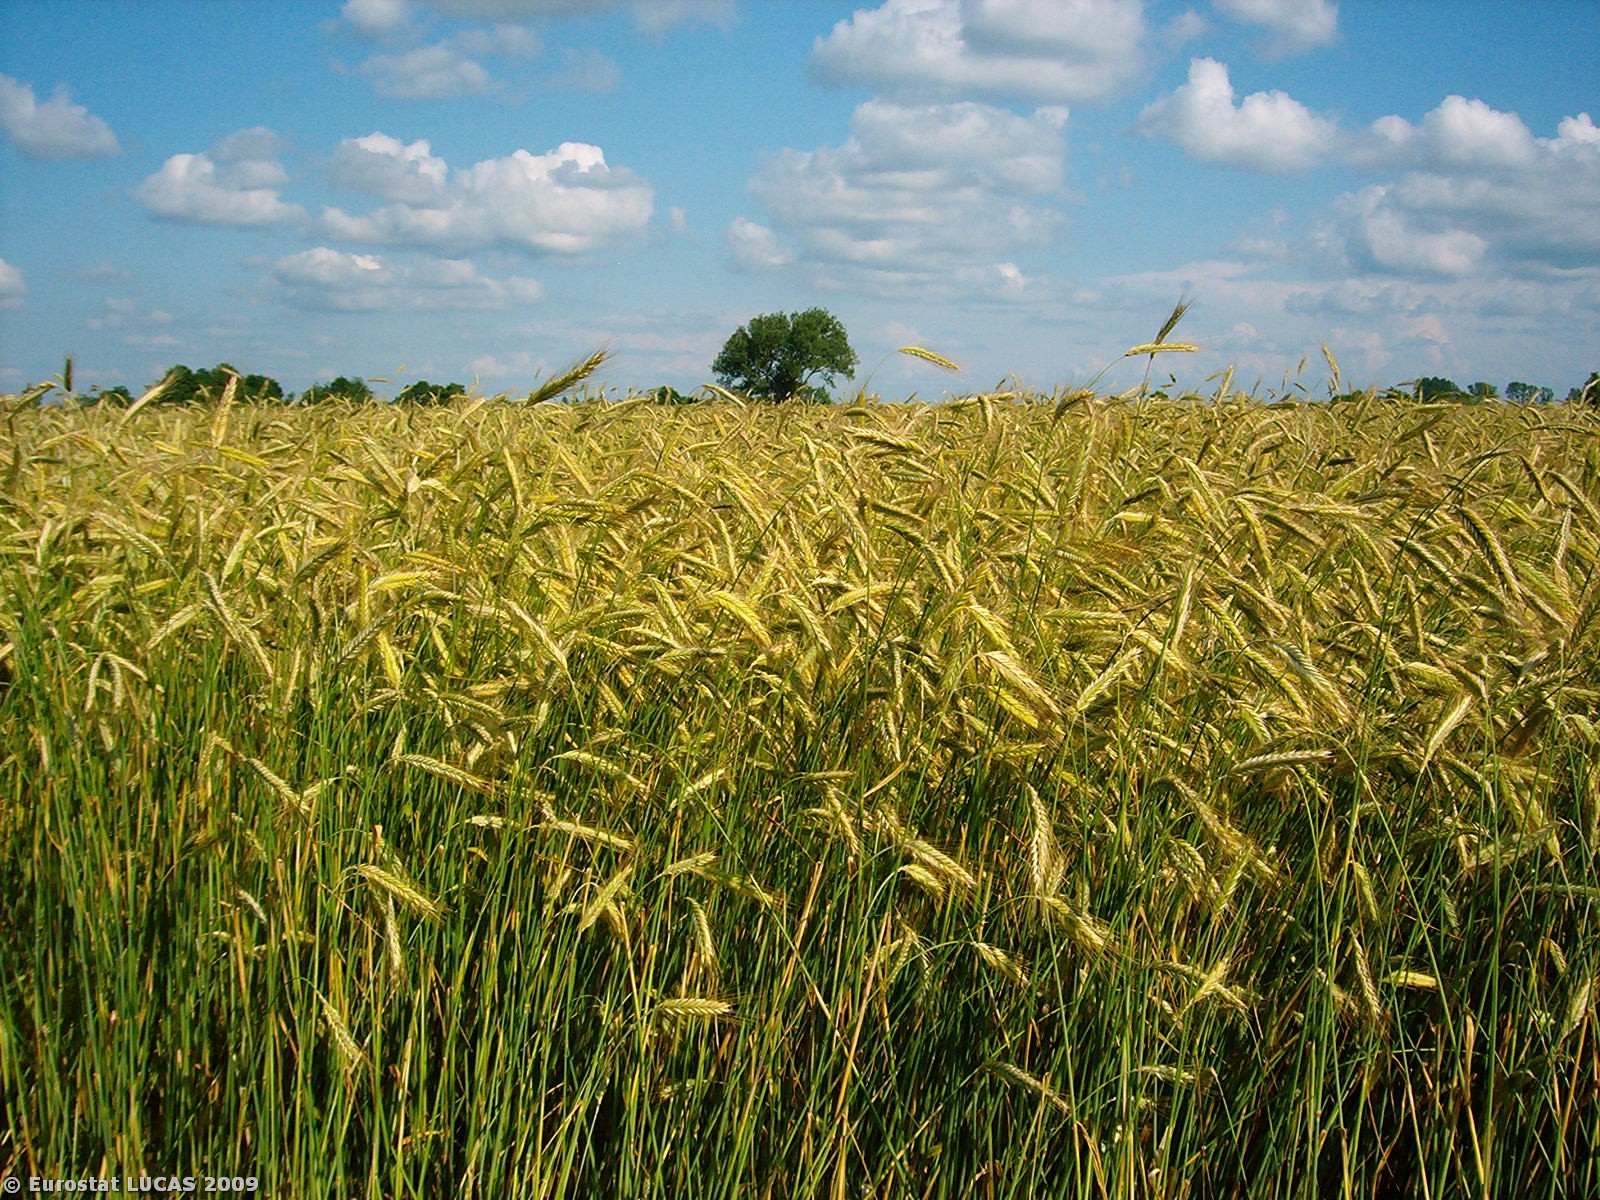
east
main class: Cropland
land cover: Triticale
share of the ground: > 75 %
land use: Agriculture (excluding fallow land and kitchen gardens)
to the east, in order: Triticale
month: July
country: PL
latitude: 53.6032
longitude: 15.4586
